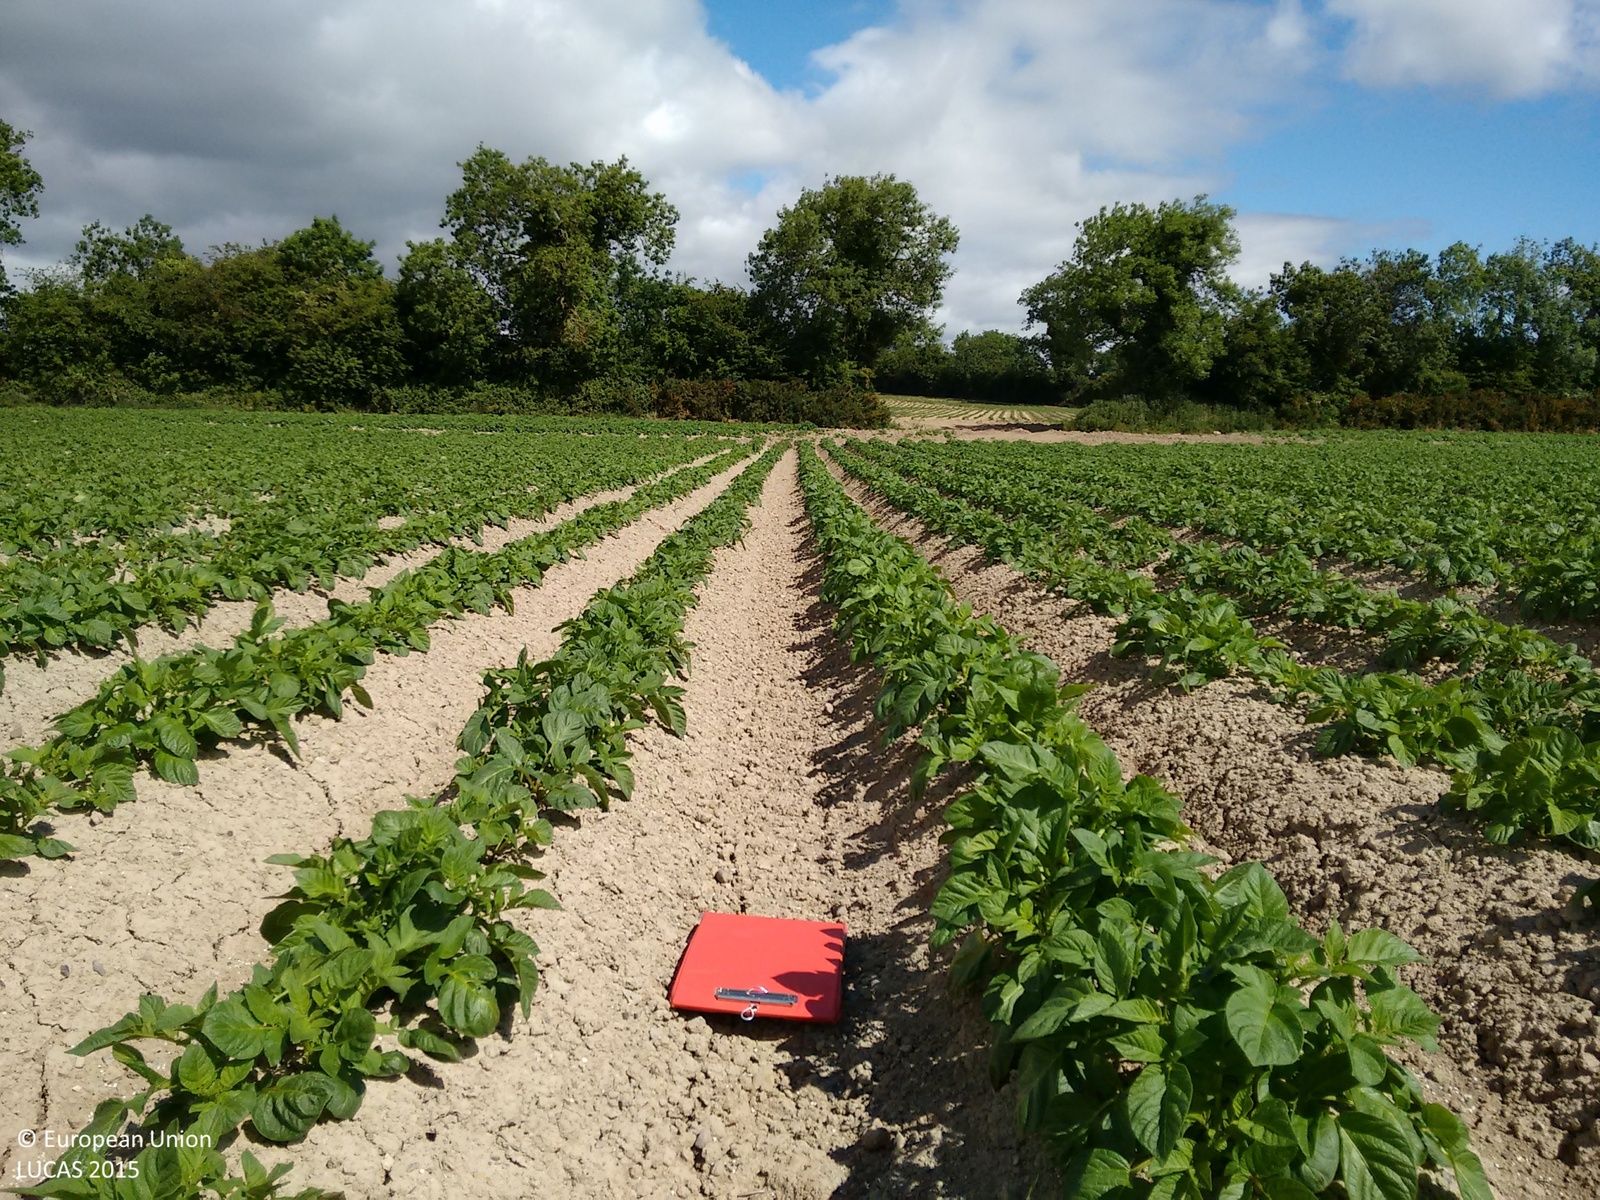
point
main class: Cropland
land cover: Potatoes
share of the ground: 50 - 75 %
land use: Agriculture (excluding fallow land and kitchen gardens)
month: June
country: IE
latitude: 53.6215
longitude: -6.3443
